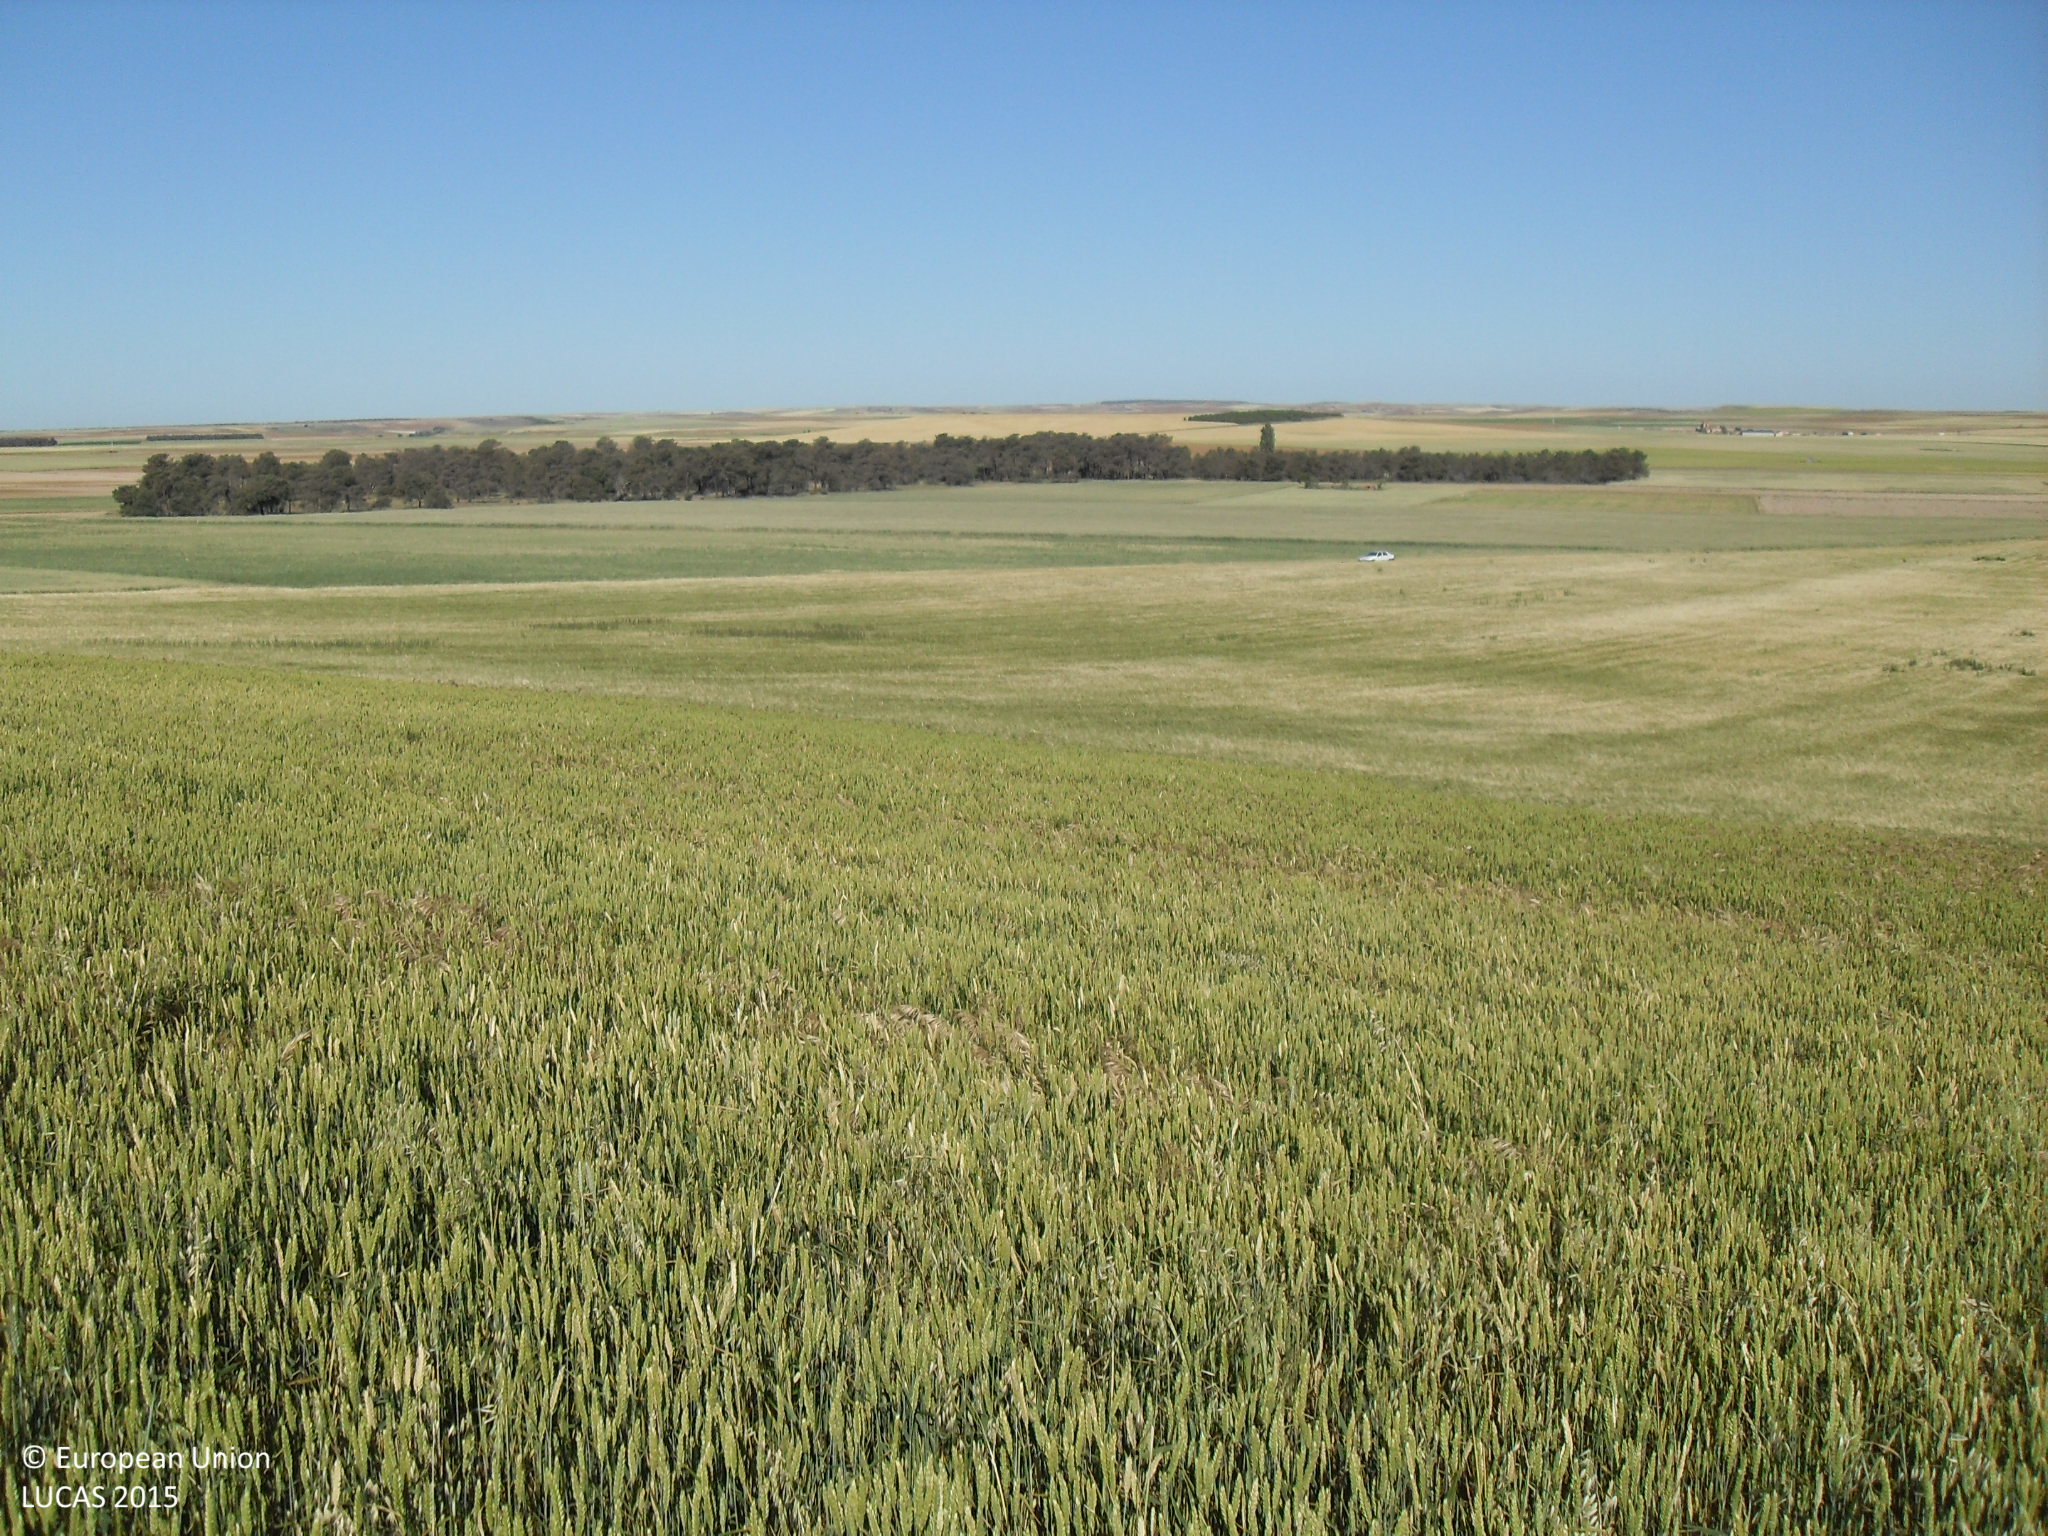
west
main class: Cropland
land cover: Common wheat
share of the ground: > 75 %
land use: Agriculture (excluding fallow land and kitchen gardens)
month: May
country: ES
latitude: 41.1657
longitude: -5.2199
